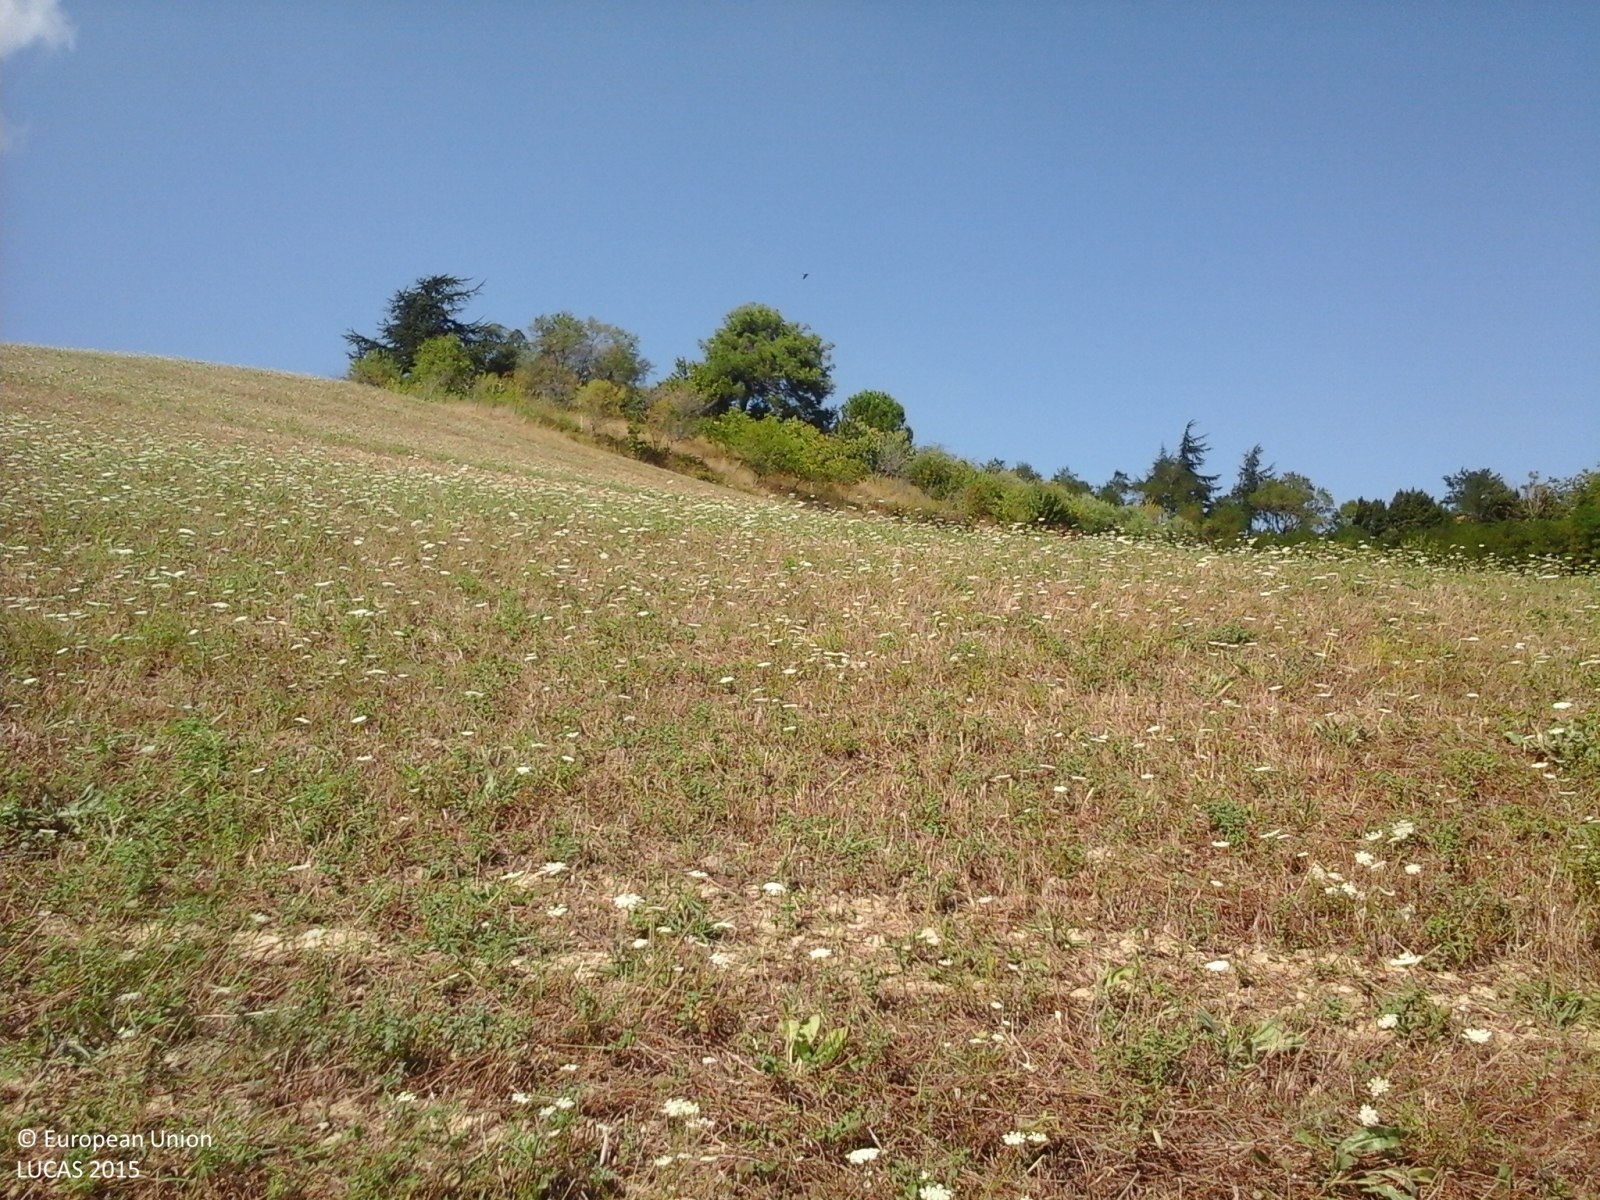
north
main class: Cropland
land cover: Other non-permanent industrial crops
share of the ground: 50 - 75 %
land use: Agriculture (excluding fallow land and kitchen gardens)
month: August
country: IT
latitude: 43.7575
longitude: 12.6391
